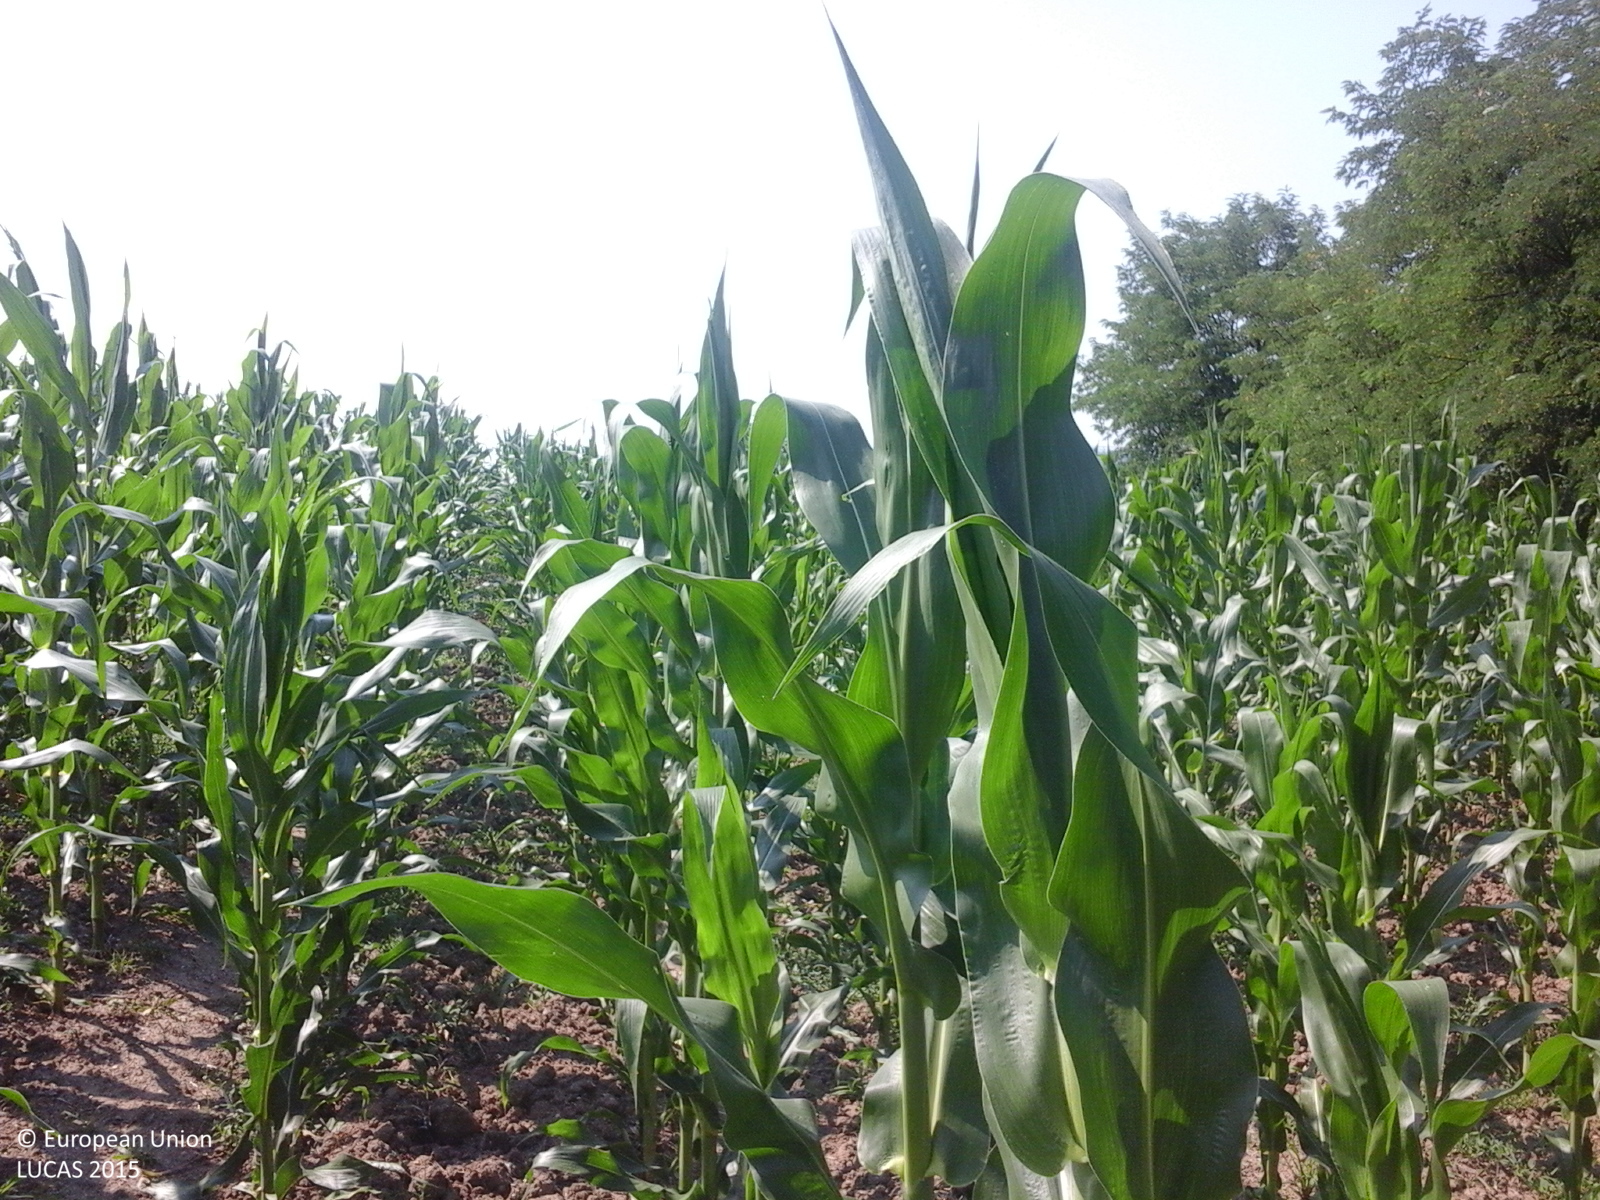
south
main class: Cropland
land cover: Maize
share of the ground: > 75 %
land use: Agriculture (excluding fallow land and kitchen gardens)
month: July
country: RO
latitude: 45.2030
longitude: 24.5532
